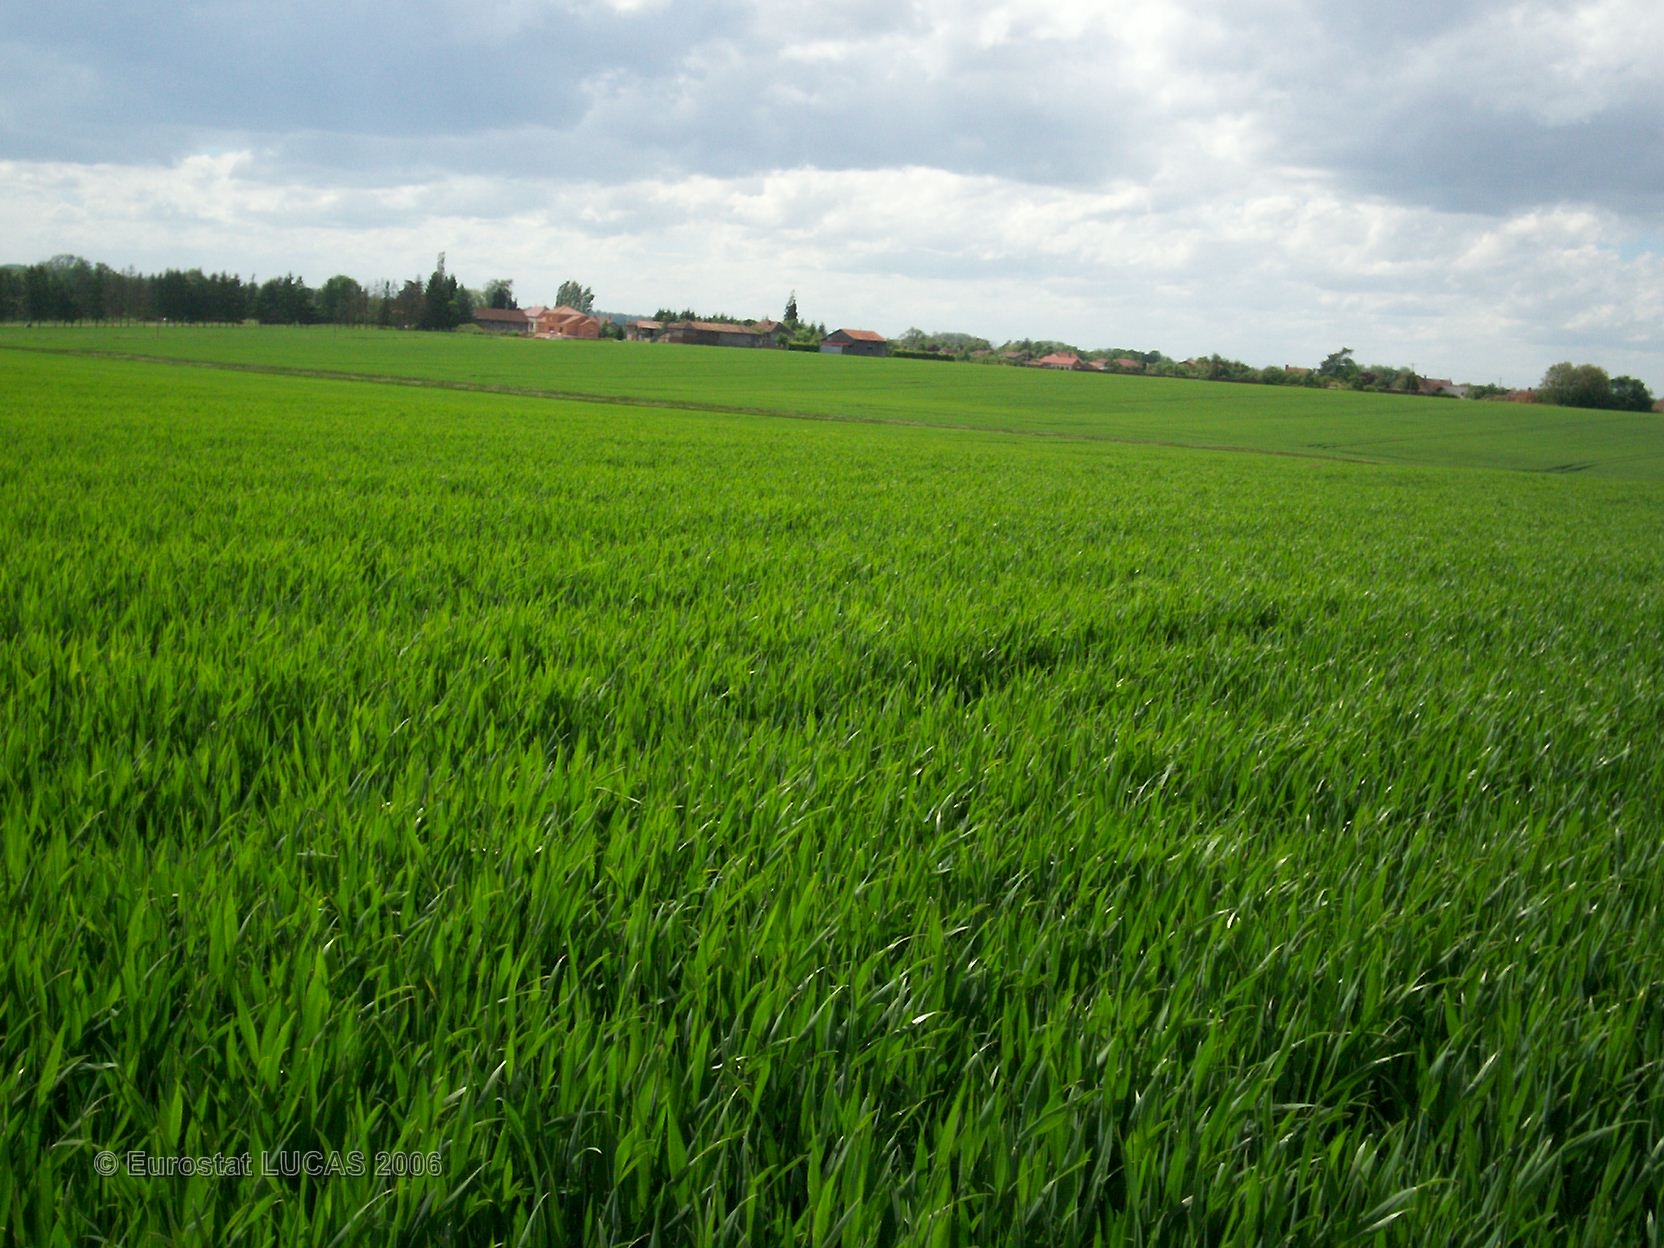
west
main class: Cropland
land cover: Common wheat
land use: Agriculture (excluding fallow land and kitchen gardens)
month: May
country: FR
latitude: 48.3916
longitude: 4.4738
